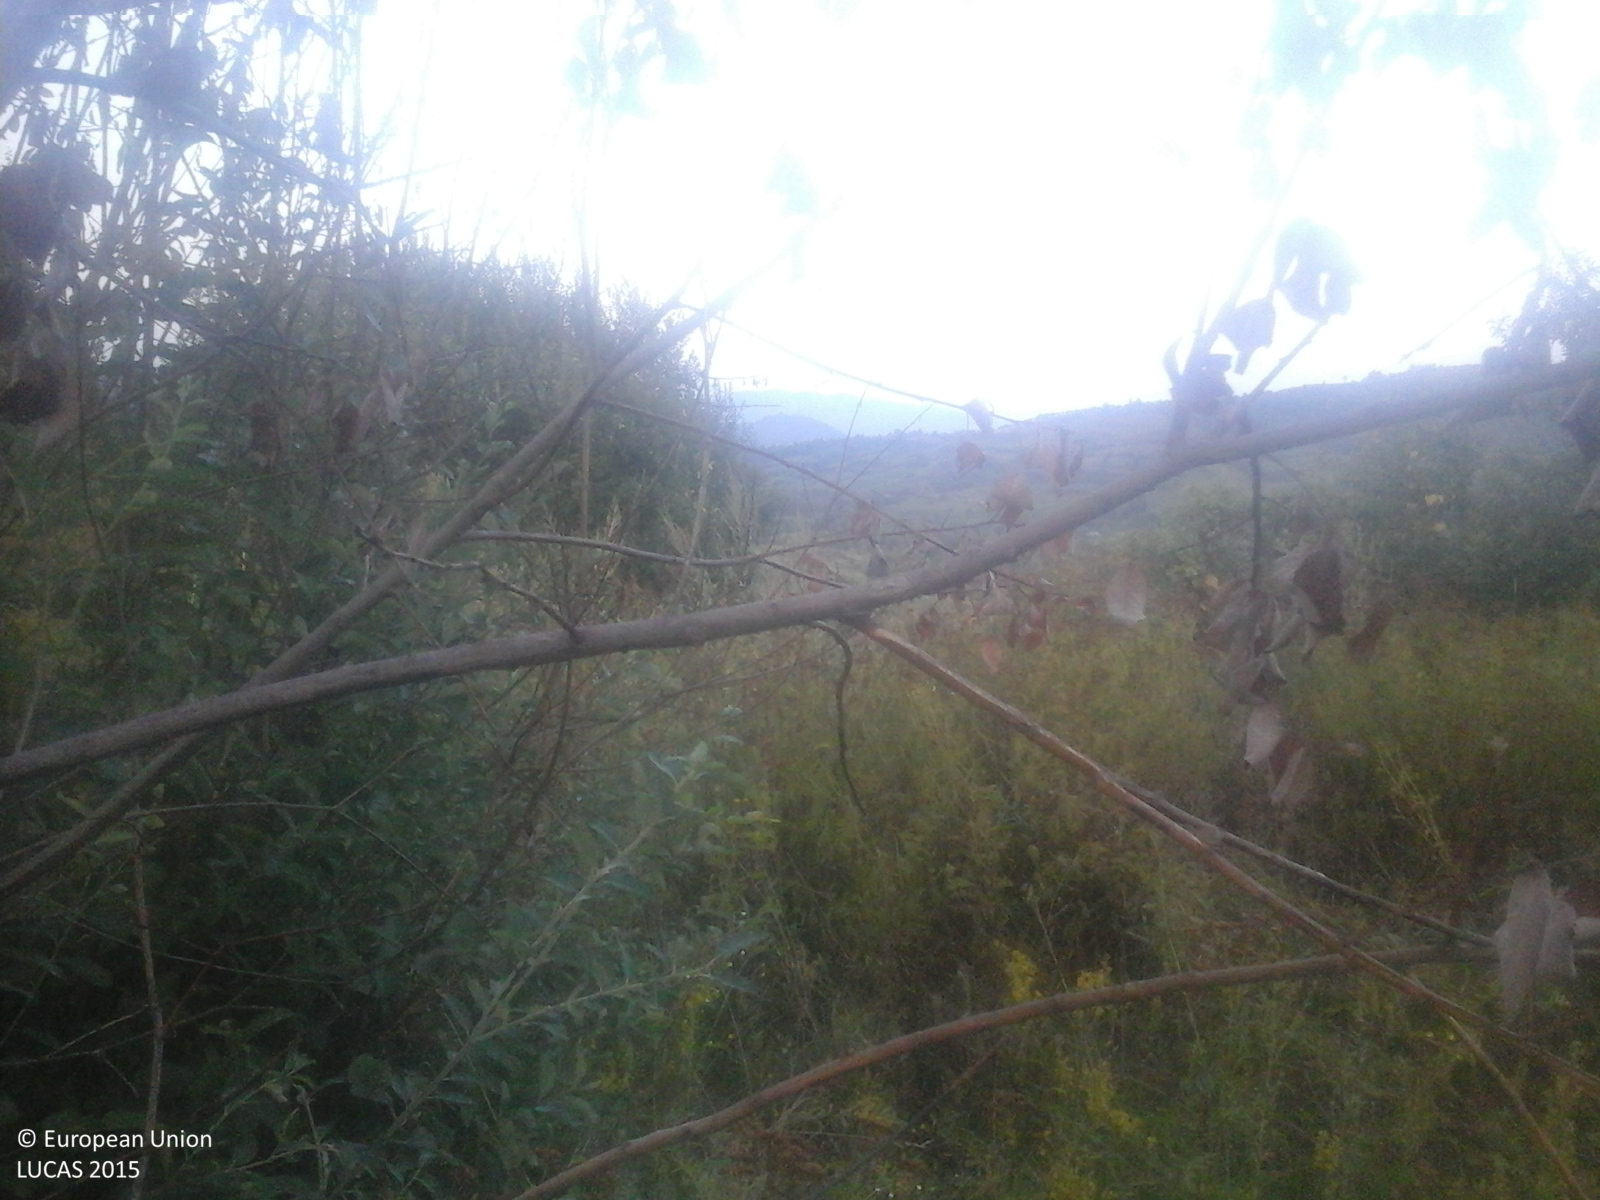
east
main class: Grassland
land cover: Grassland with sparse tree/shrub cover
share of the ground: > 75 %
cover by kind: herbaceous plants 85 %, shrubs 10 %, broadleaved forest trees 5 %
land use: Agriculture (excluding fallow land and kitchen gardens)
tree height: < 5 m
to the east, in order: Grassland with sparse tree/shrub cover; Tracks; Spontaneously vegetated surfaces; Broadleaved woodland; Grassland with sparse tree/shrub cover; Grassland without tree/shrub cover; Abandoned hedges; Fences; Spontaneously vegetated surfaces; Tracks; Grassland without tree/shrub cover; Fences; Spontaneously vegetated surfaces; Potatoes; Grassland without tree/shrub cover; Lines of trees; Grassland without tree/shrub cover; Abandoned hedges; Grassland without tree/shrub cover; Abandoned hedges; Grassland without tree/shrub cover; Abandoned hedges; Tracks; Grassland without tree/shrub cover; Abandoned hedges; Spontaneously vegetated surfaces; Potatoes; Spontaneously vegetated surfaces; Abandoned hedges; Spontaneously vegetated surfaces
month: September
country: RO
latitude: 47.6547
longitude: 24.2693
